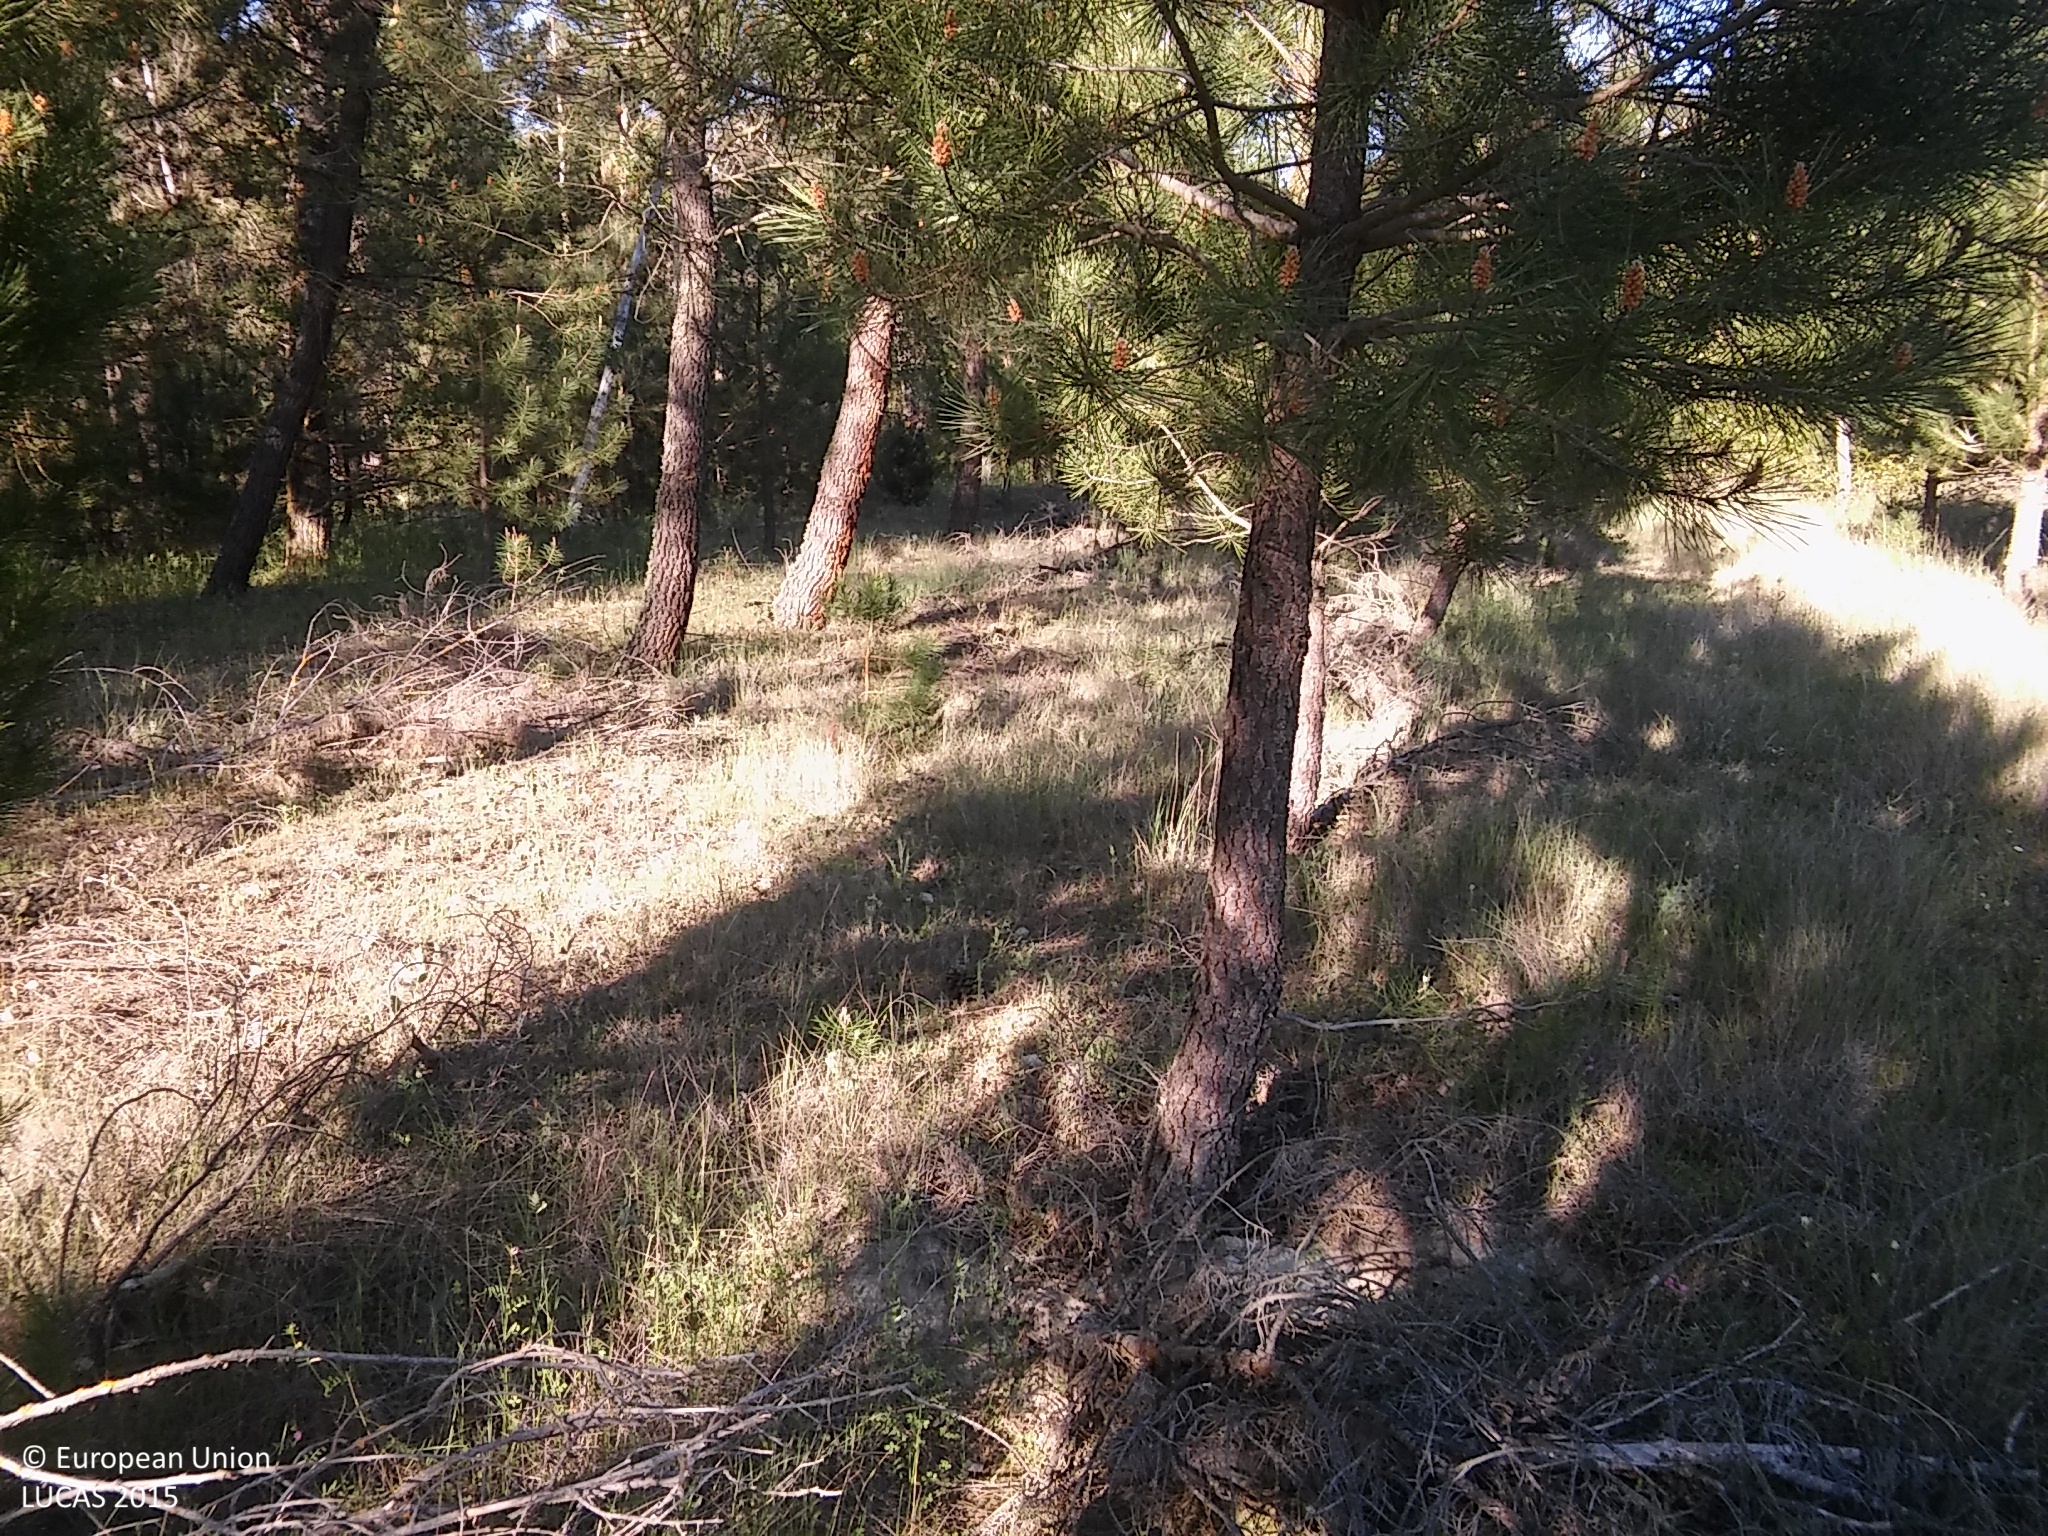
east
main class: Woodland
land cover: Pine dominated coniferous woodland
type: coniferous forest of the mediterranean region
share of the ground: 10 - 25 %
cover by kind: herbaceous plants 65 %, shrubs 25 %, coniferous forest trees 10 %
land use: Forestry
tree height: > 5 m
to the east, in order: Pine dominated coniferous woodland; Broadleaved woodland; Tracks; Pine dominated coniferous woodland; Ditches and canals; Pine dominated coniferous woodland; Ditches and canals; Pine dominated coniferous woodland; Ditches and canals; Pine dominated coniferous woodland
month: May
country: ES
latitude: 41.3256
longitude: -4.0201
